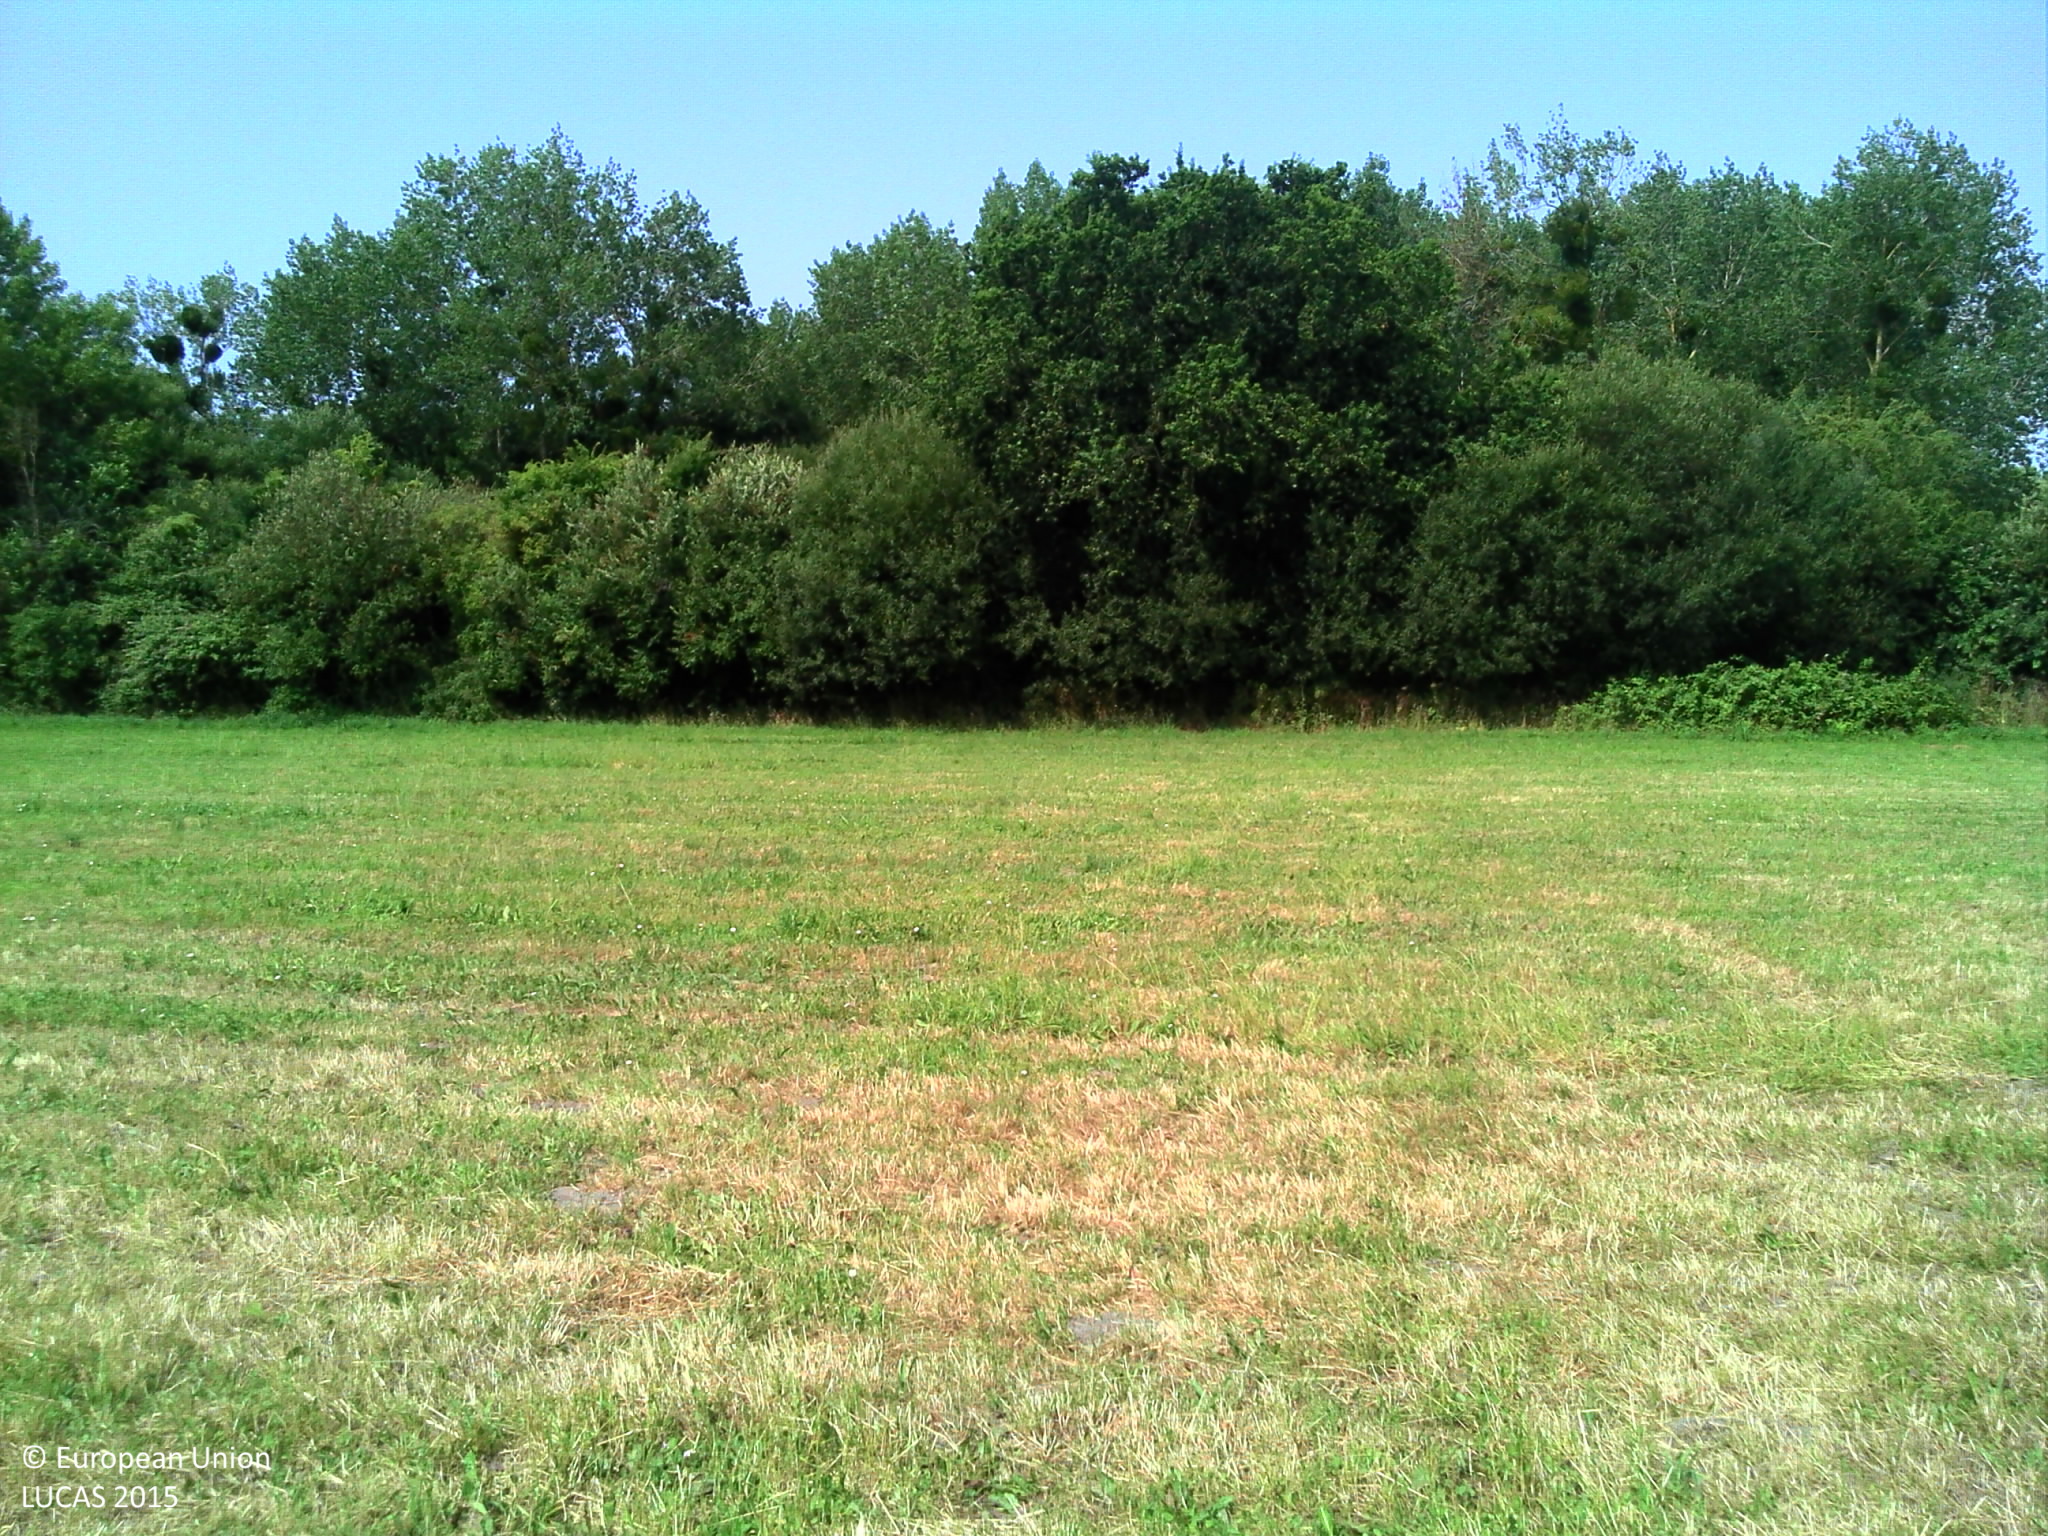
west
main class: Grassland
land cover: Grassland without tree/shrub cover
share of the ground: > 75 %
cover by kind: herbaceous plants 100 %
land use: Agriculture (excluding fallow land and kitchen gardens)
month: July
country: FR
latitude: 48.8868
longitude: -1.5455
